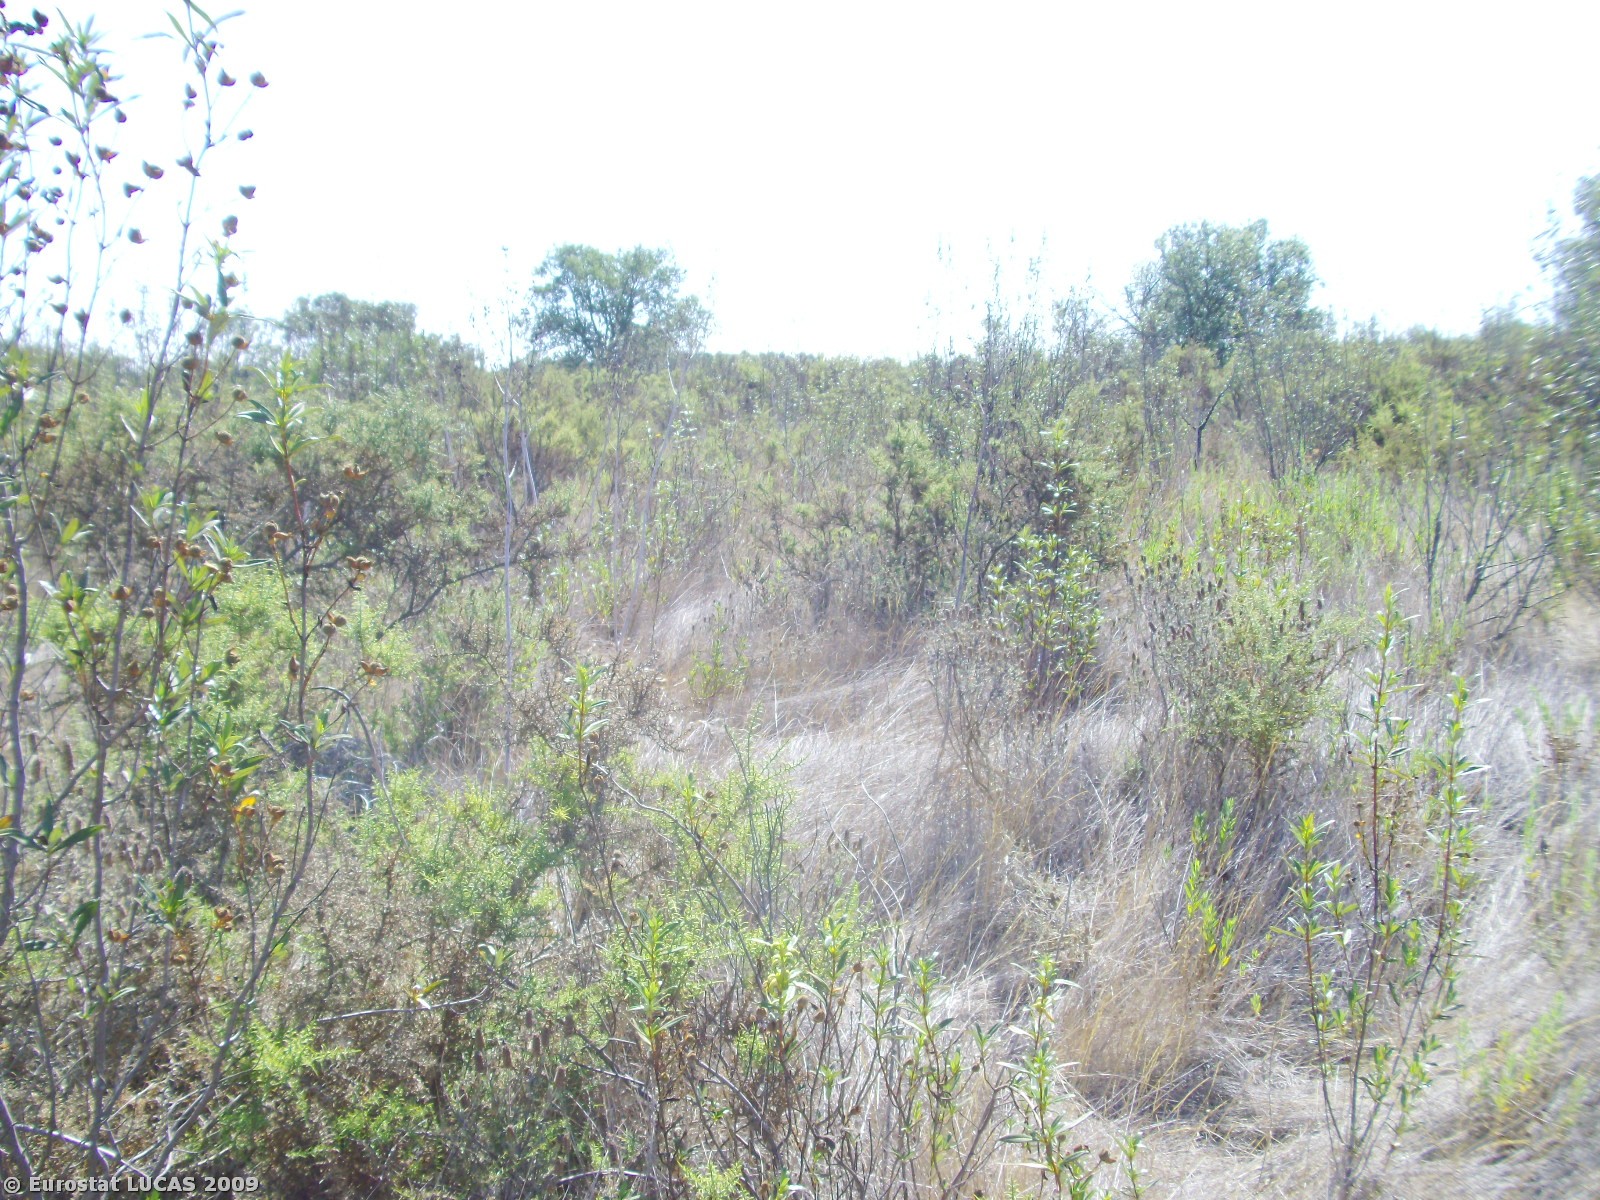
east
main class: Shrubland
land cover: Shrubland without tree cover
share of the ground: > 75 %
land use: Unused
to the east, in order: Shrubland without tree cover; Shrubland with sparse tree cover; Shrubland without tree cover
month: August
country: PT
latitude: 38.6262
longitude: -8.7508
